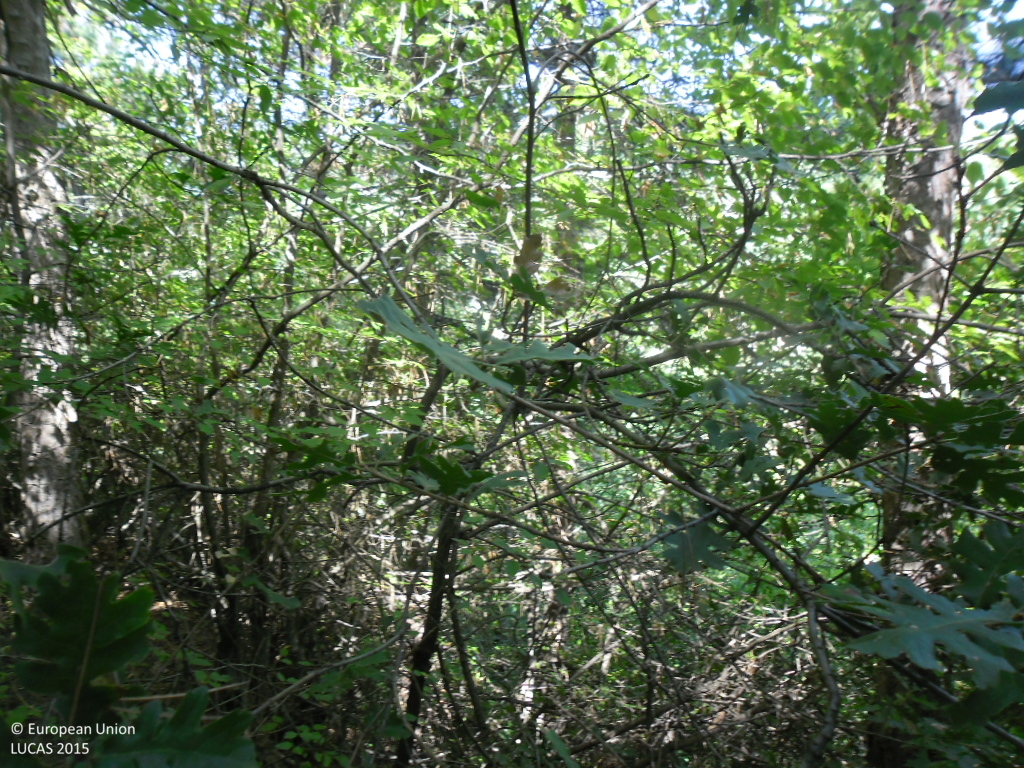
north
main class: Woodland
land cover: Other mixed woodland
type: hemiboreal forest and nemoral coniferous forest and mixed broadleaved-coniferous forest
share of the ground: > 75 %
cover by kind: coniferous forest trees 75 %, broadleaved forest trees 25 %
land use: Forestry
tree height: > 5 m
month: September
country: BG
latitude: 41.7422
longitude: 23.1162
